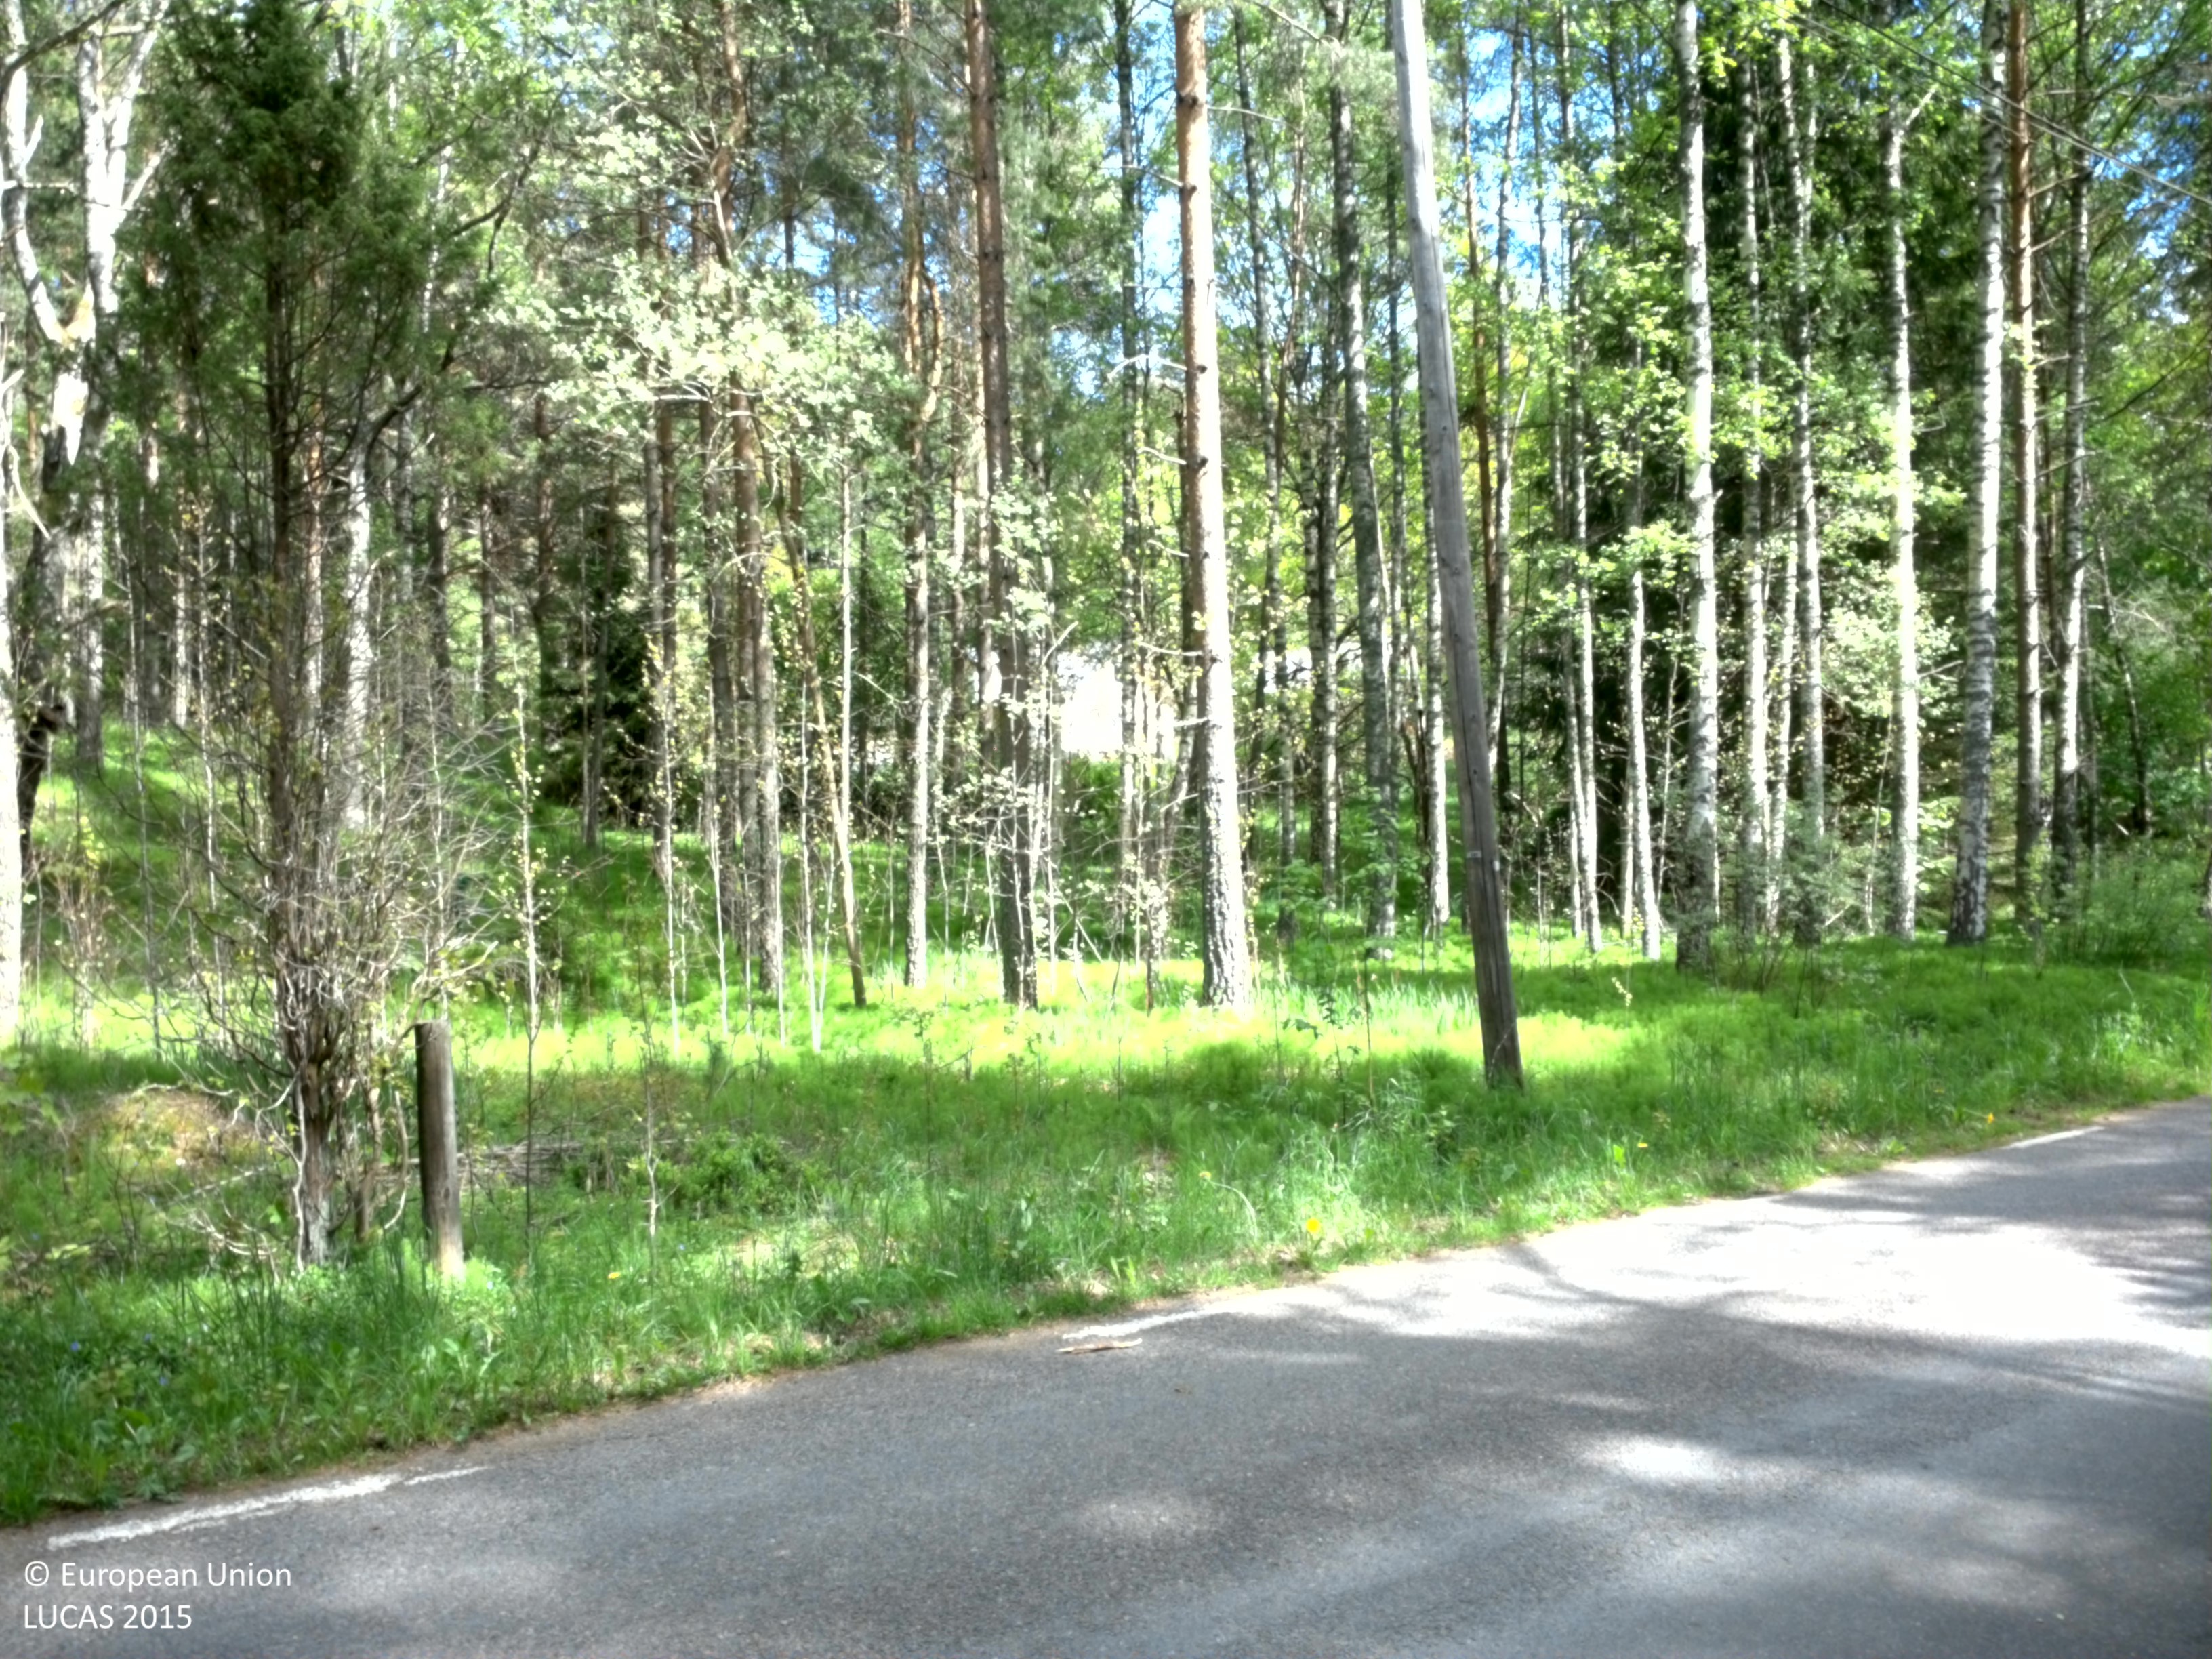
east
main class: Grassland
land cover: Grassland with sparse tree/shrub cover
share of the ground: > 75 %
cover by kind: herbaceous plants 70 %, lichens and mosses 10 %, consolidated bare surface 10 %, broadleaved forest trees 5 %, shrubs 5 %
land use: Road transport
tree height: > 5 m
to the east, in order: Grassland with sparse tree/shrub cover; Paved roads, cycling and walking lanes; Grass margins; Ditches and canals; Electric lines; Pine dominated mixed woodland; Shrubland with sparse tree cover; Artificial constructions in urban areas; Grassland without tree/shrub cover; Broadleaved woodland; Pine dominated mixed woodland; Pine dominated coniferous woodland
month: May
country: SE
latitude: 57.3520
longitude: 15.8647
